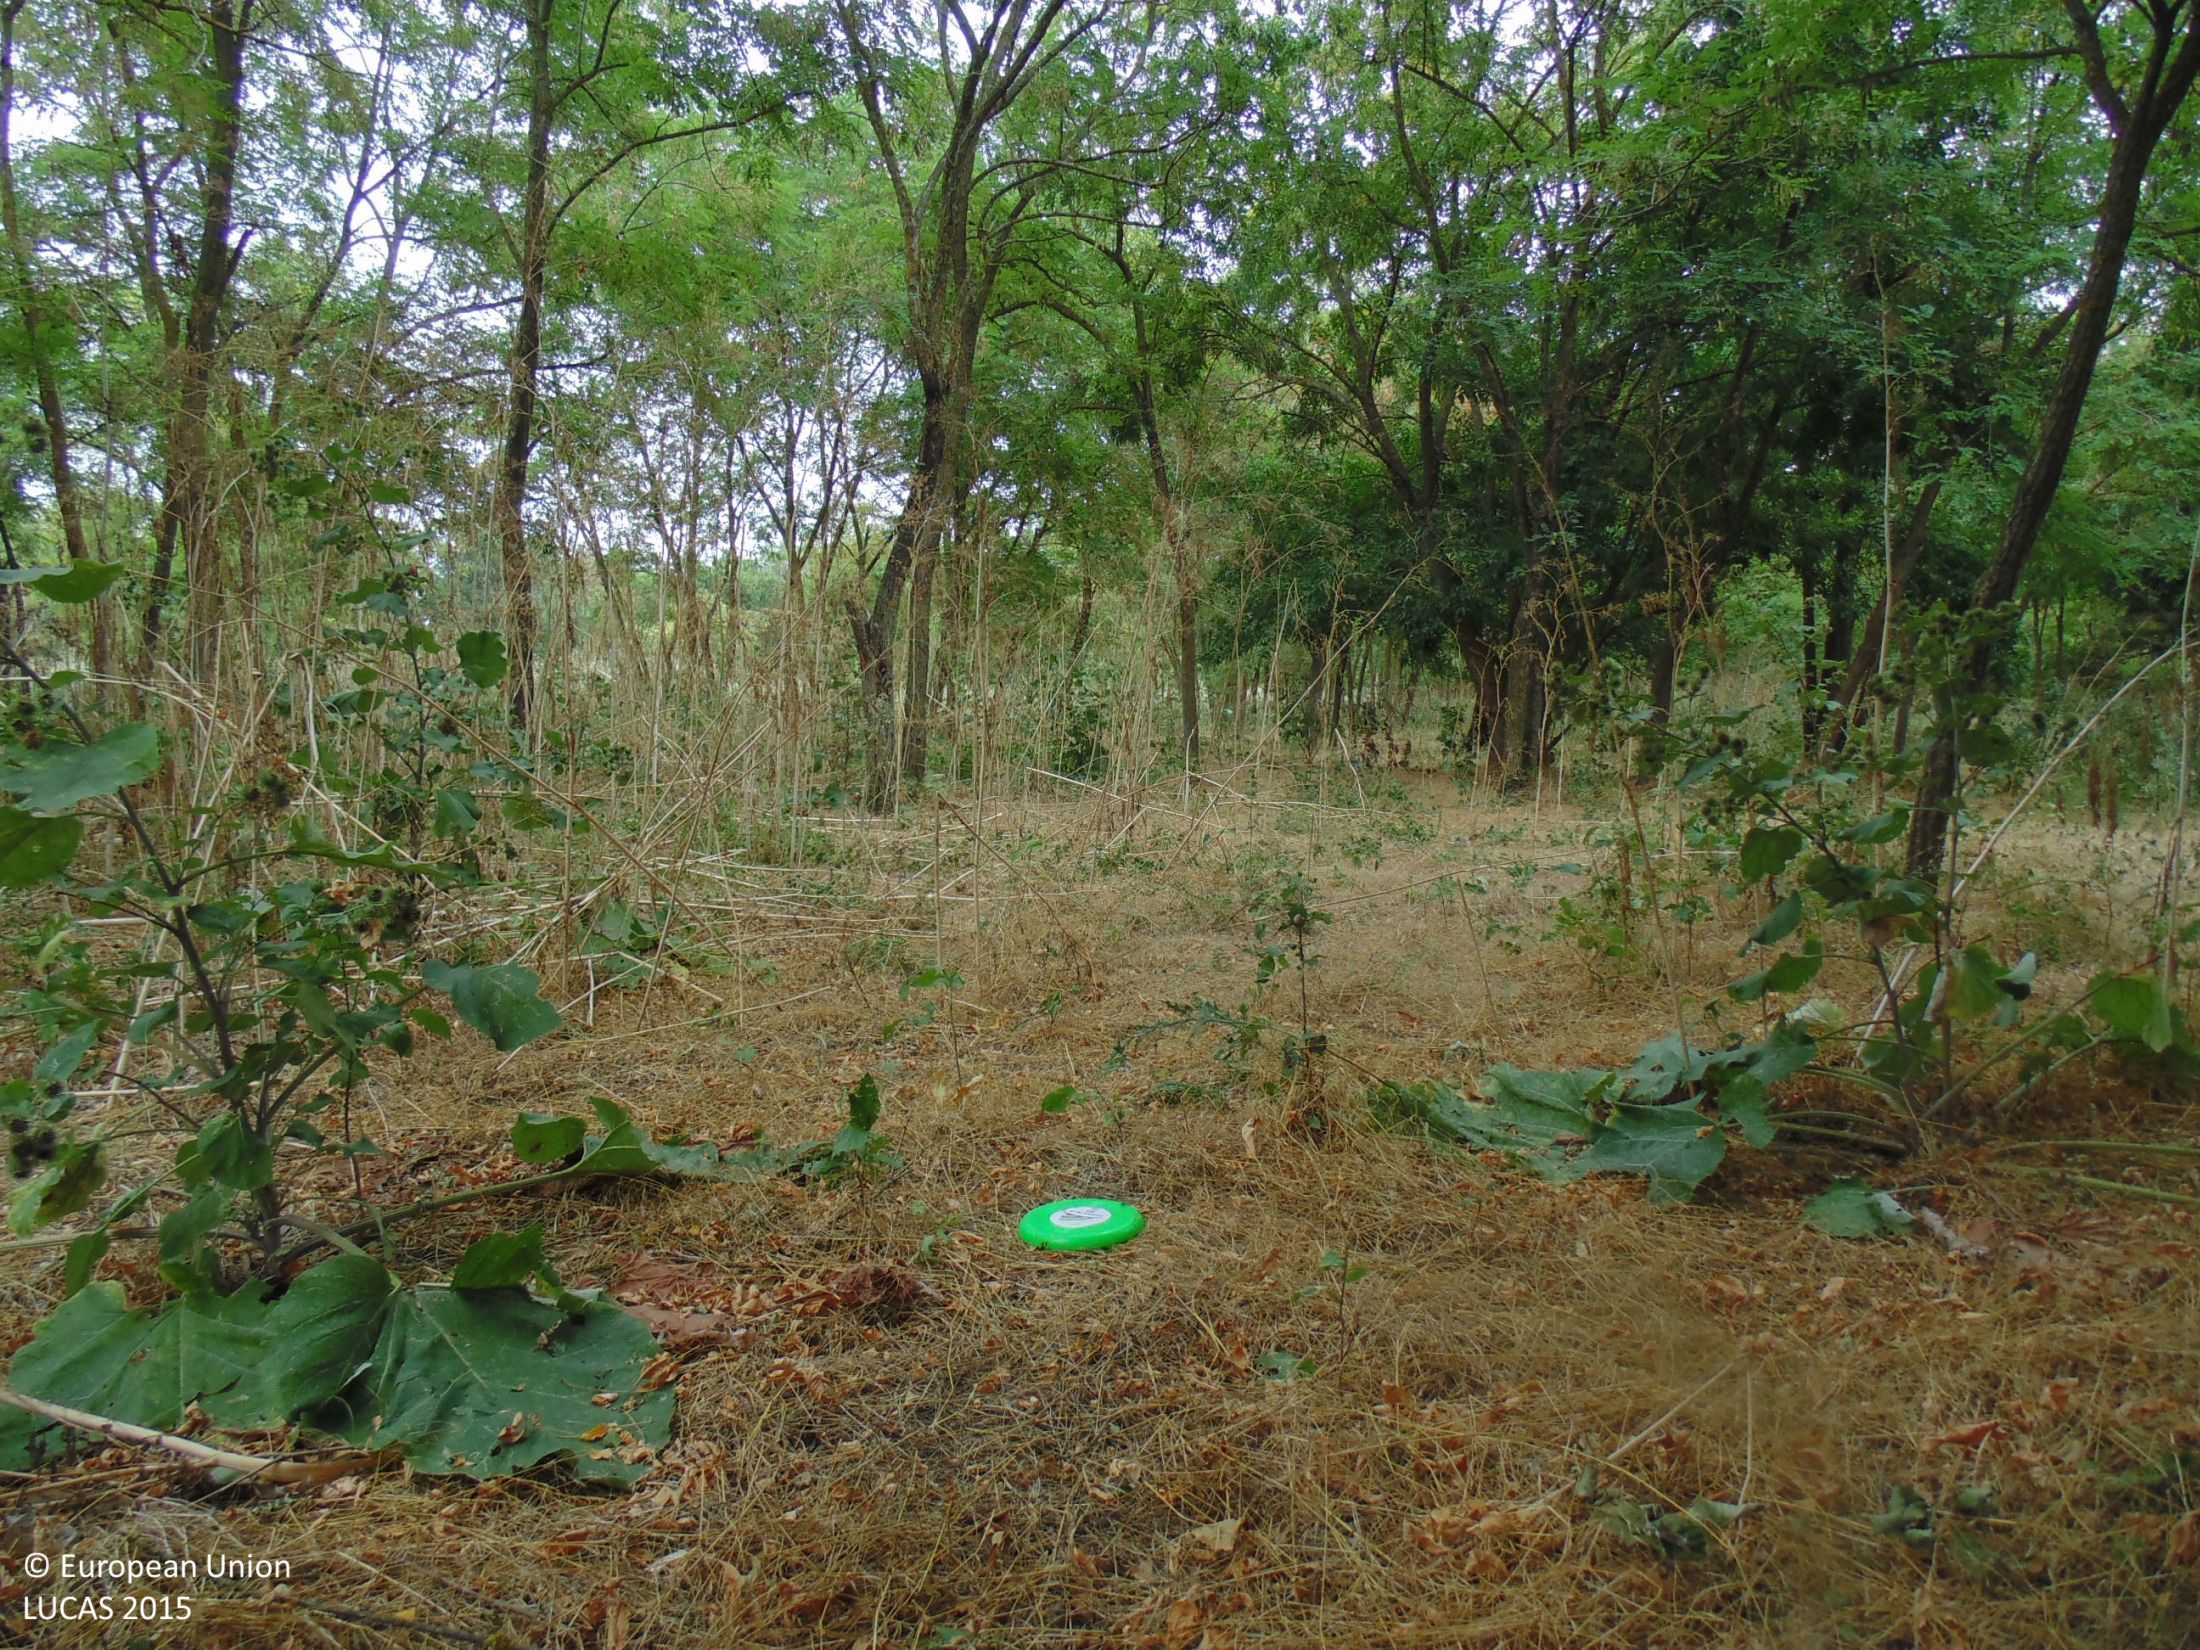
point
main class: Woodland
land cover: Broadleaved woodland
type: mesophytic deciduous forest
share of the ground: > 75 %
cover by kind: broadleaved forest trees 90 %, shrubs 10 %
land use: Forestry
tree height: > 5 m
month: August
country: BG
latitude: 43.5695
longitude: 28.5248
